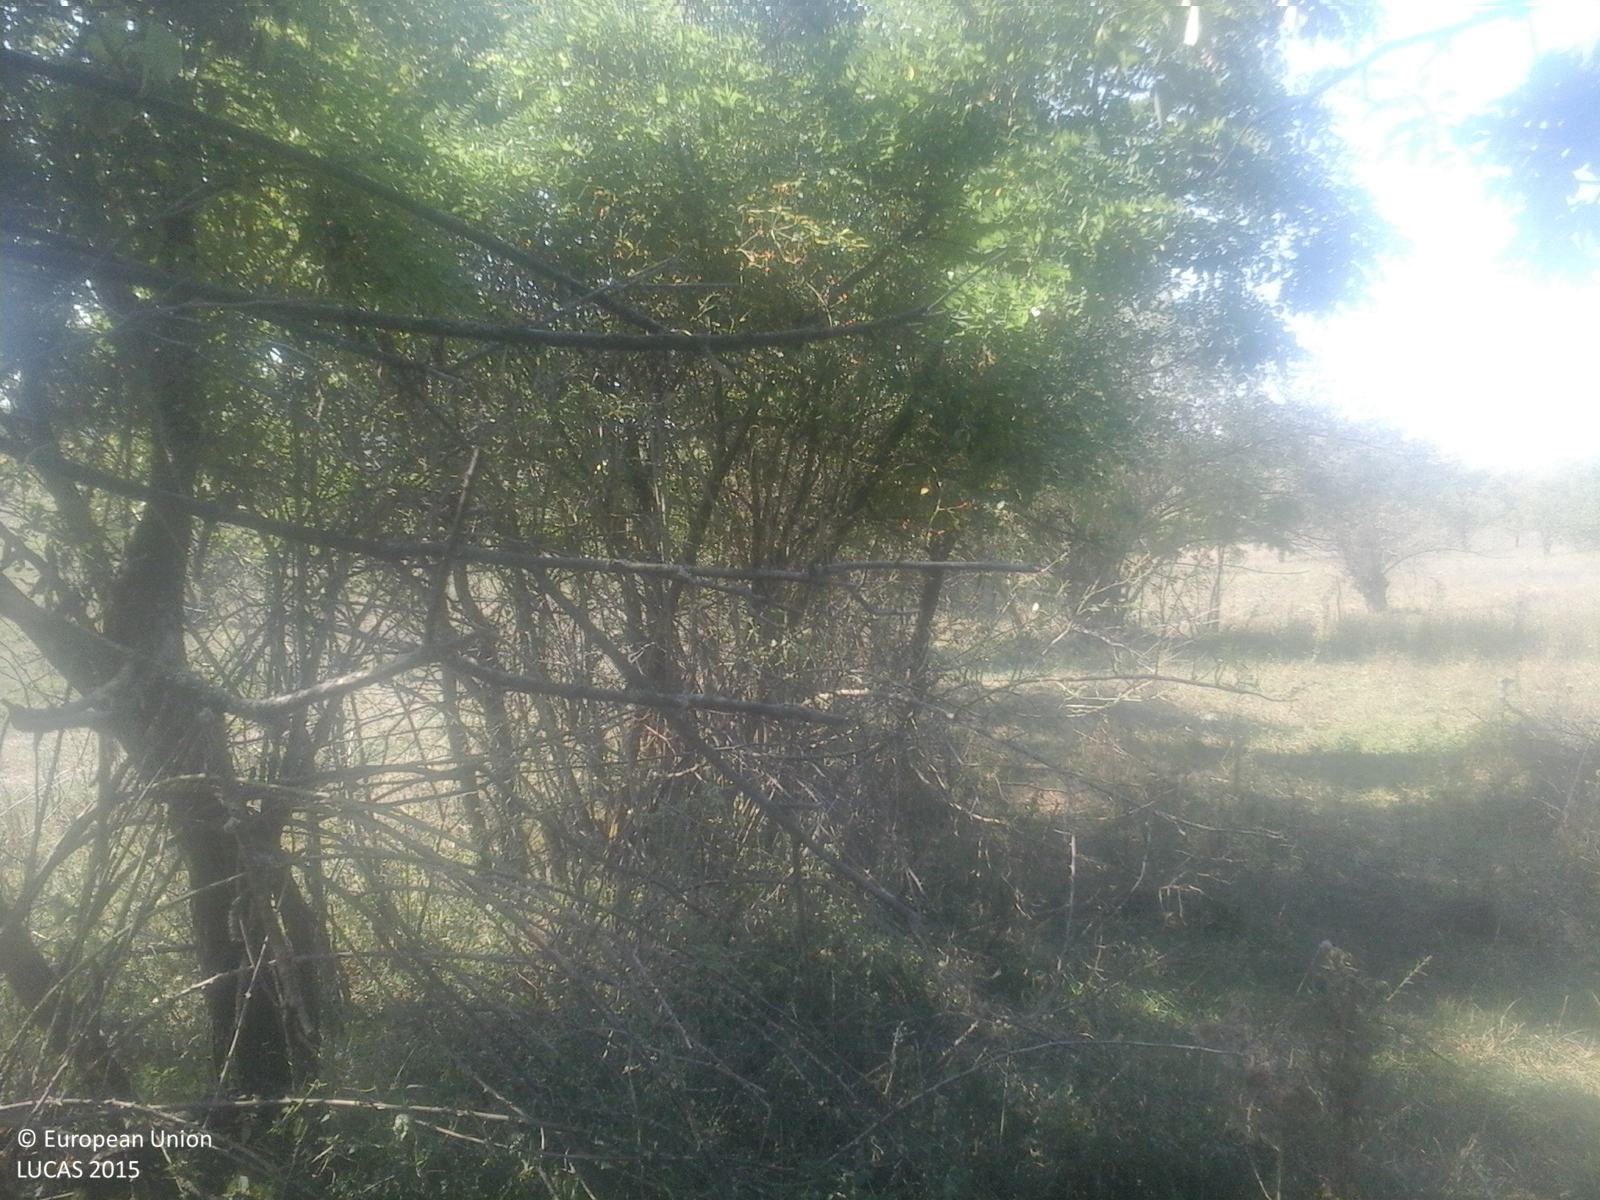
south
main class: Grassland
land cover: Grassland with sparse tree/shrub cover
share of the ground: > 75 %
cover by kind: herbaceous plants 85 %, shrubs 10 %, broadleaved forest trees 5 %
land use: Agriculture (excluding fallow land and kitchen gardens)
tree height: < 5 m
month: September
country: RO
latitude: 46.8063
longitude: 24.4631
